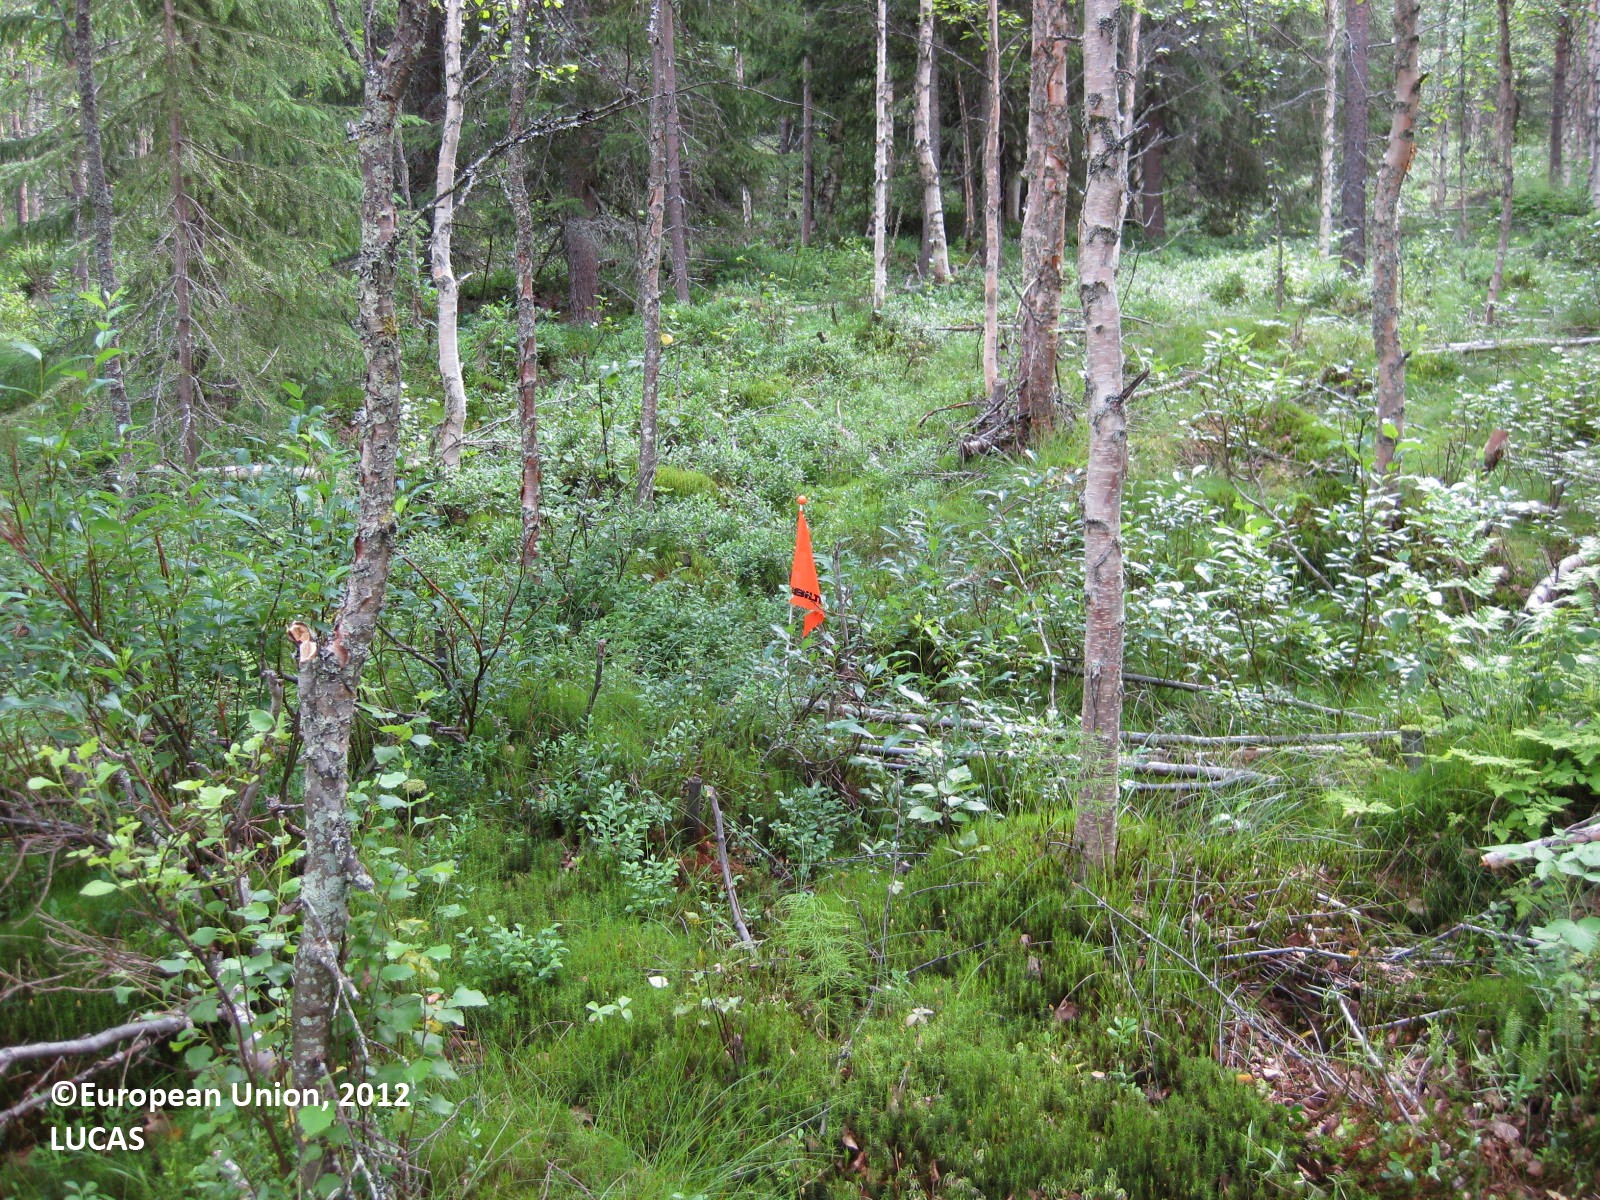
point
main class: Woodland
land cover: Other mixed woodland
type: boreal forest
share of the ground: > 75 %
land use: Forestry
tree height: > 5 m
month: July
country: FI
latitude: 65.6861
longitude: 28.5079
